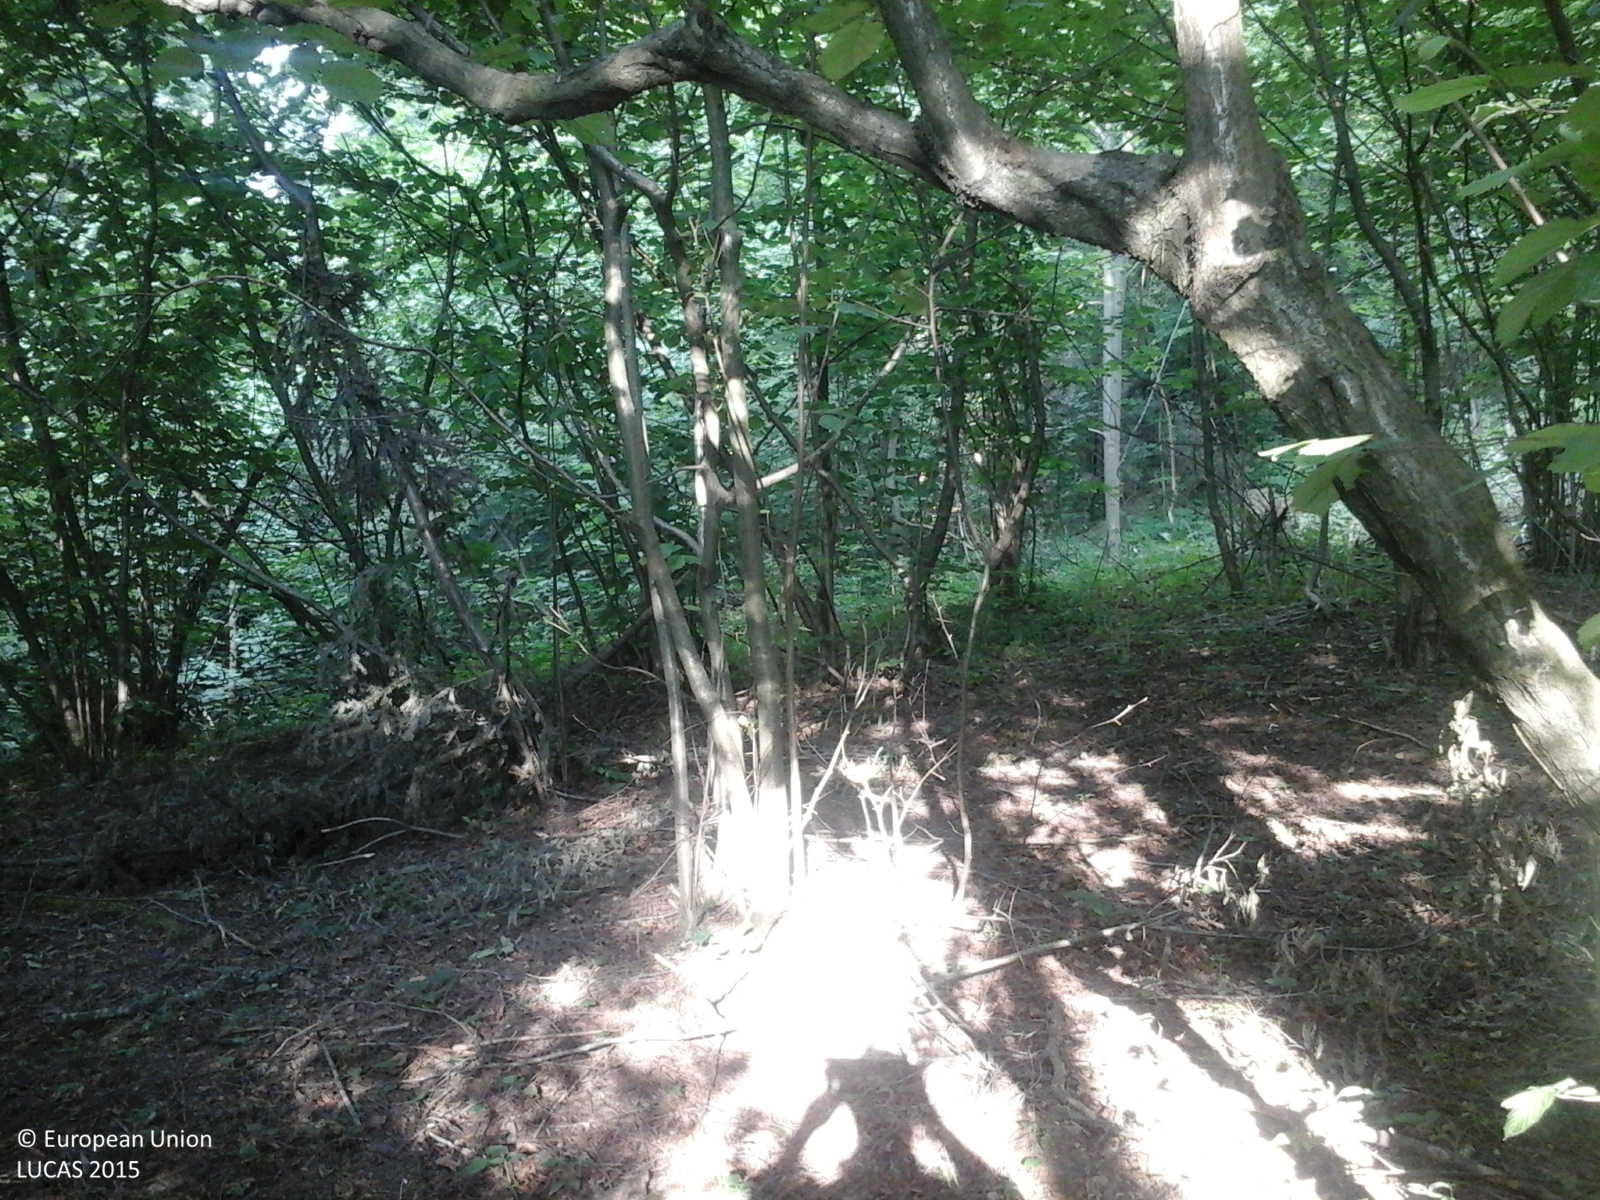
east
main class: Woodland
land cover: Spruce dominated mixed woodland
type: alpine coniferous forest
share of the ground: > 75 %
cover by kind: coniferous forest trees 75 %, broadleaved forest trees 25 %
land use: Forestry
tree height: > 5 m
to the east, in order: Spruce dominated mixed woodland; Broadleaved woodland; Grassland without tree/shrub cover; Lines of trees; Artificial constructions in urban areas; Grassland without tree/shrub cover; Artificial constructions in urban areas; Grassland without tree/shrub cover; Artificial constructions in urban areas; Grassland without tree/shrub cover; Grass margins; Lines of trees; Paved roads, cycling and walking lanes; Lines of trees; Grass margins; Lines of trees; Shrubland with sparse tree cover
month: June
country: RO
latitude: 47.6929
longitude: 25.8347
